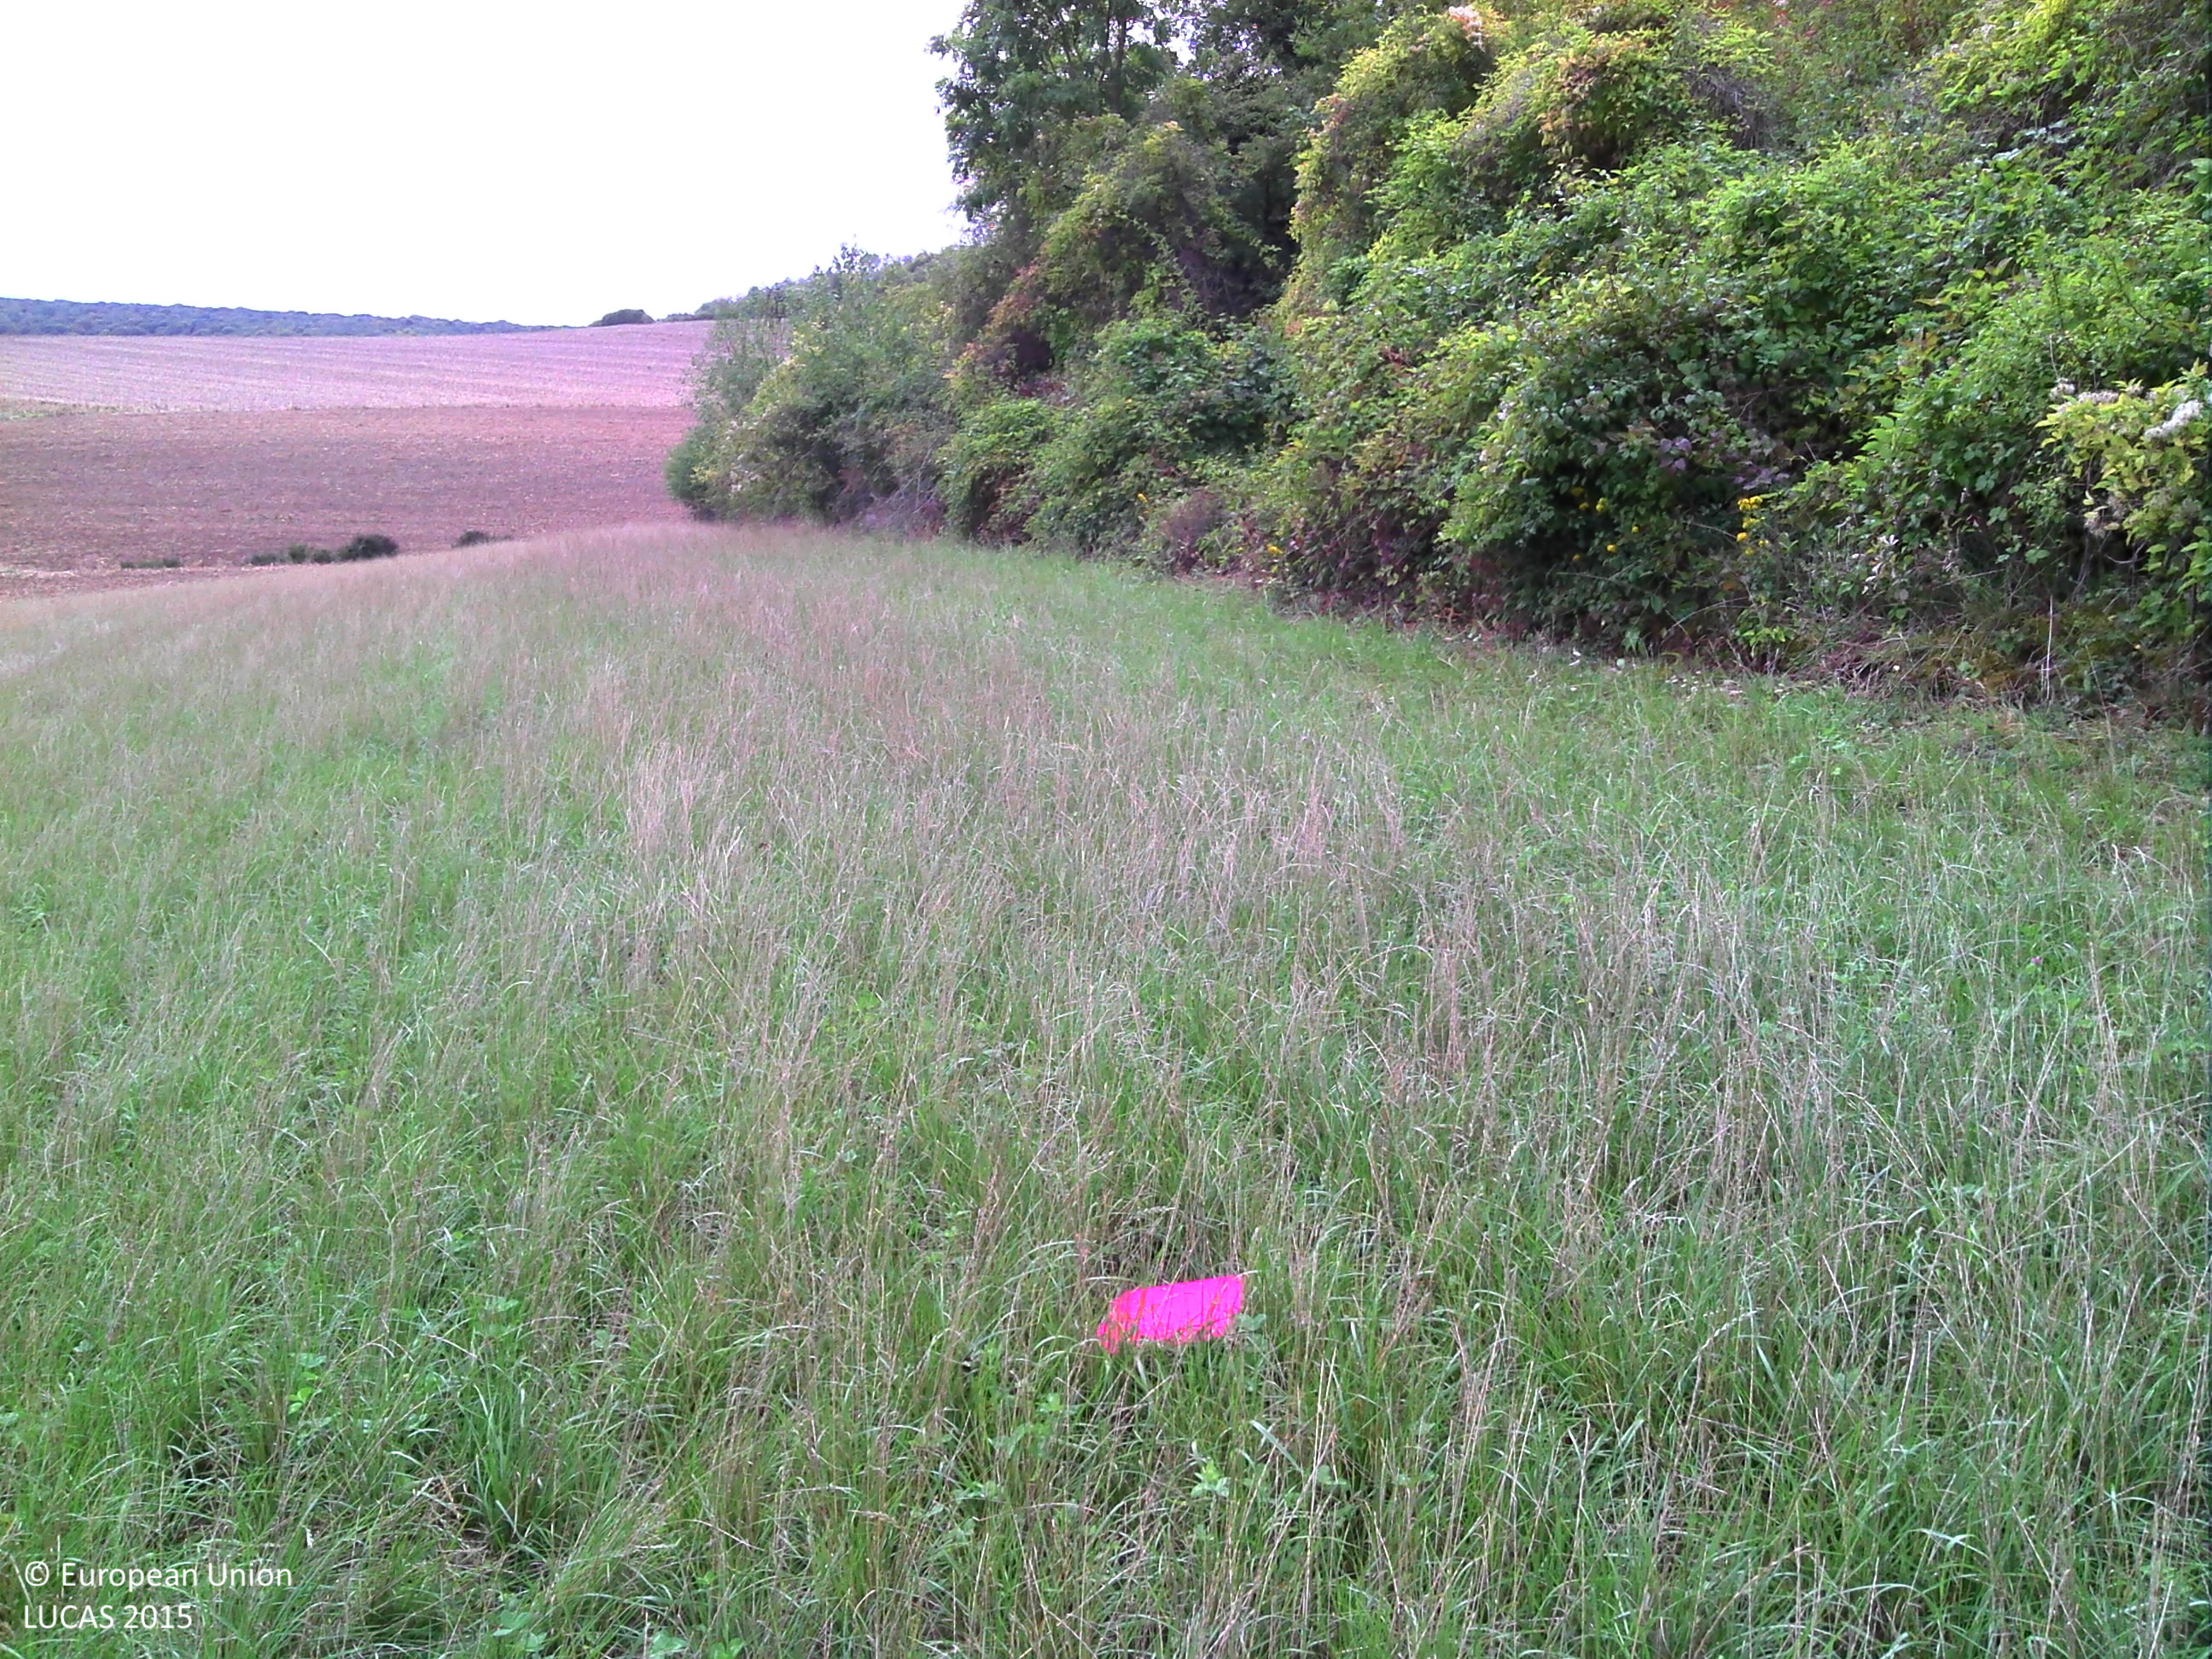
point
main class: Cropland
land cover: Temporary grasslands
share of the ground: > 75 %
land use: Agriculture (excluding fallow land and kitchen gardens)
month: September
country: FR
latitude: 48.1842
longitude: 4.6583
